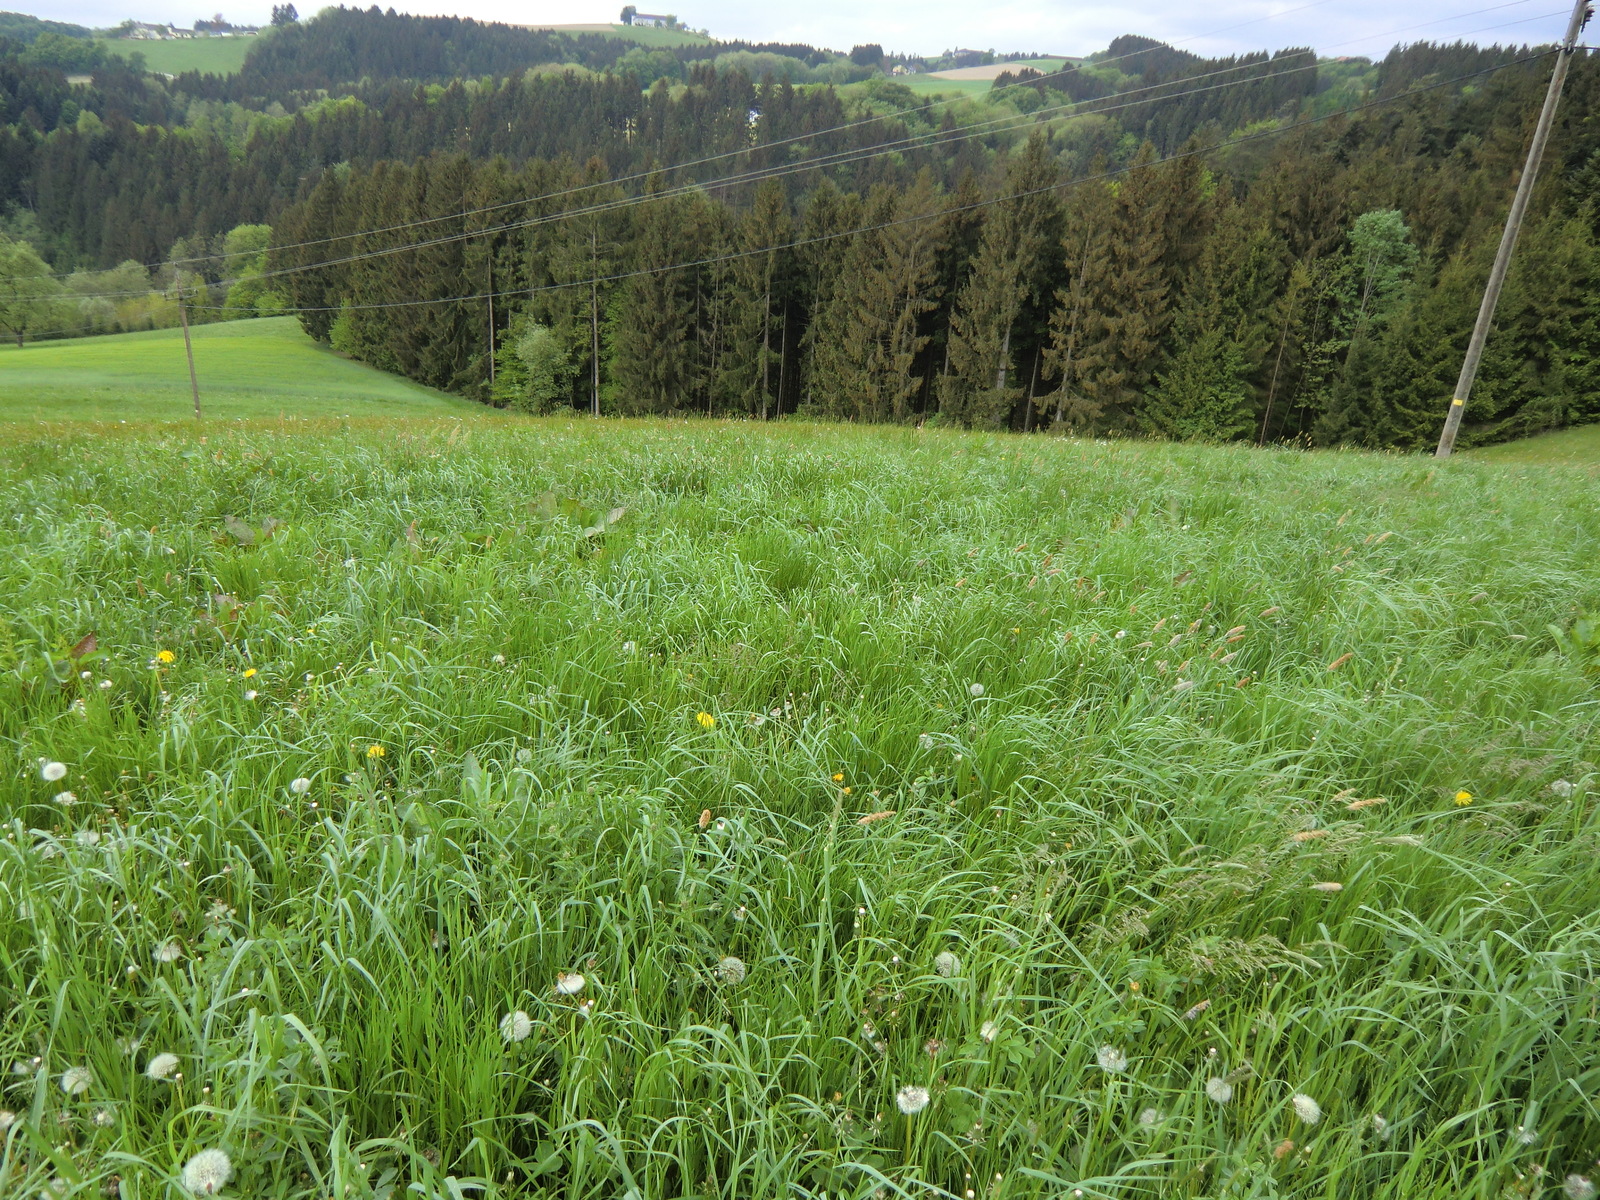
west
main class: Grassland
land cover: Grassland without tree/shrub cover
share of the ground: > 75 %
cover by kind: herbaceous plants 100 %
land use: Agriculture (excluding fallow land and kitchen gardens)
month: May
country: AT
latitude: 48.2437
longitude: 14.8352
